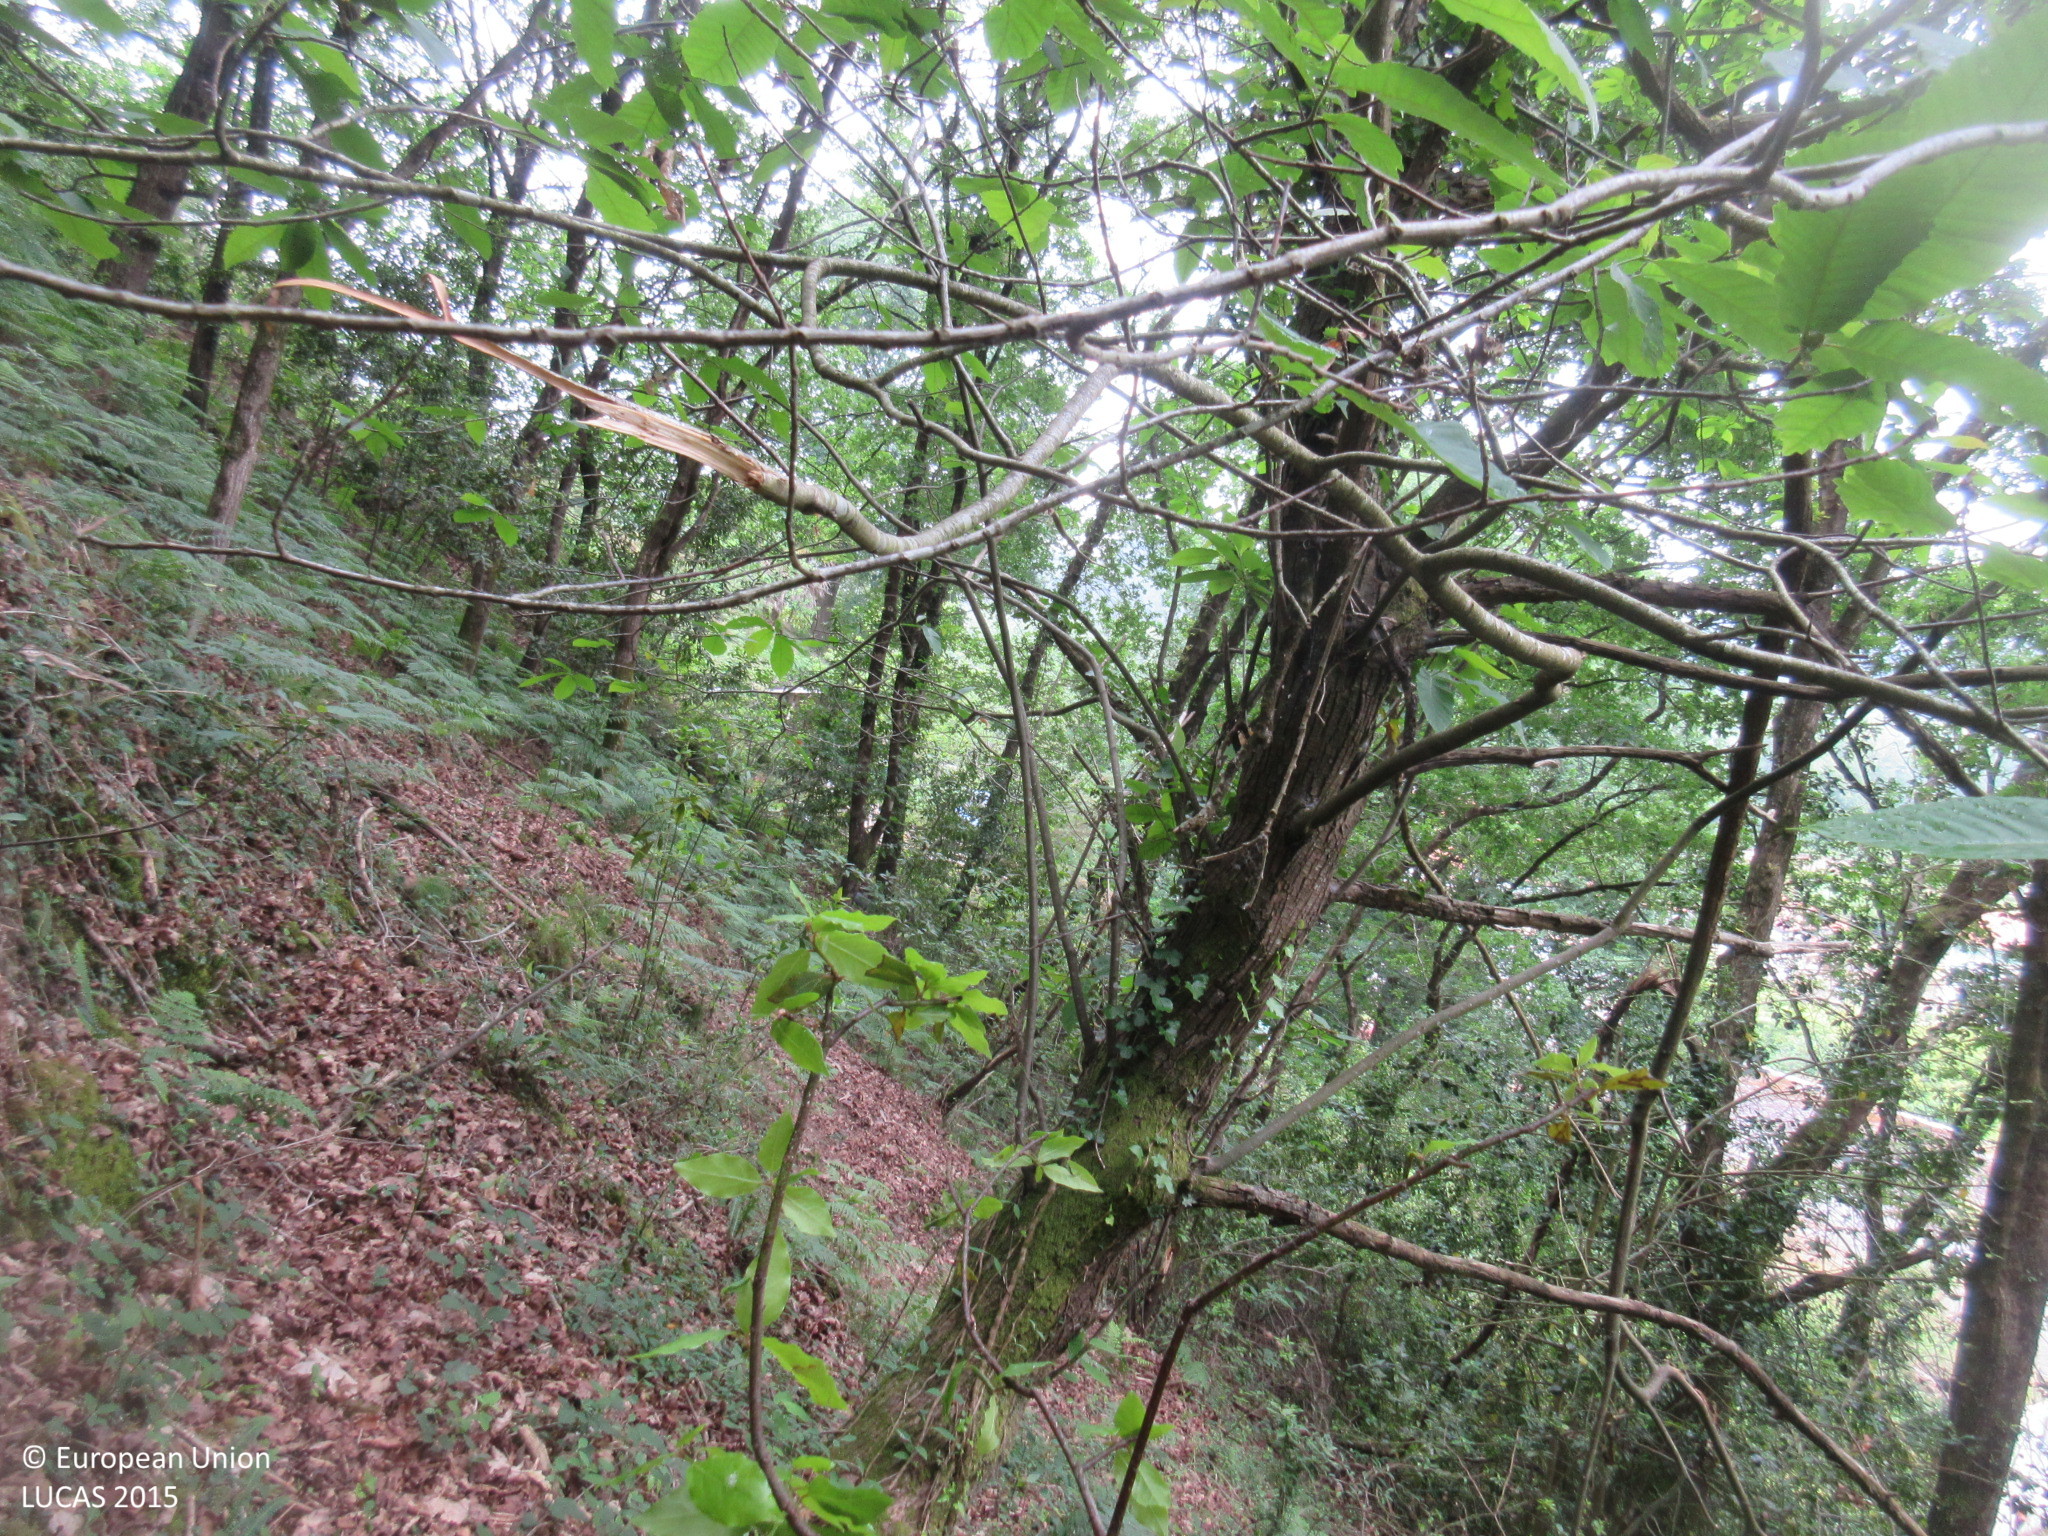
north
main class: Woodland
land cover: Broadleaved woodland
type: thermophilous deciduous forest
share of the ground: > 75 %
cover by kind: broadleaved forest trees 95 %, shrubs 5 %
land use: Forestry
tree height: > 5 m
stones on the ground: < 10 %
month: June
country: ES
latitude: 43.3456
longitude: -3.4267
